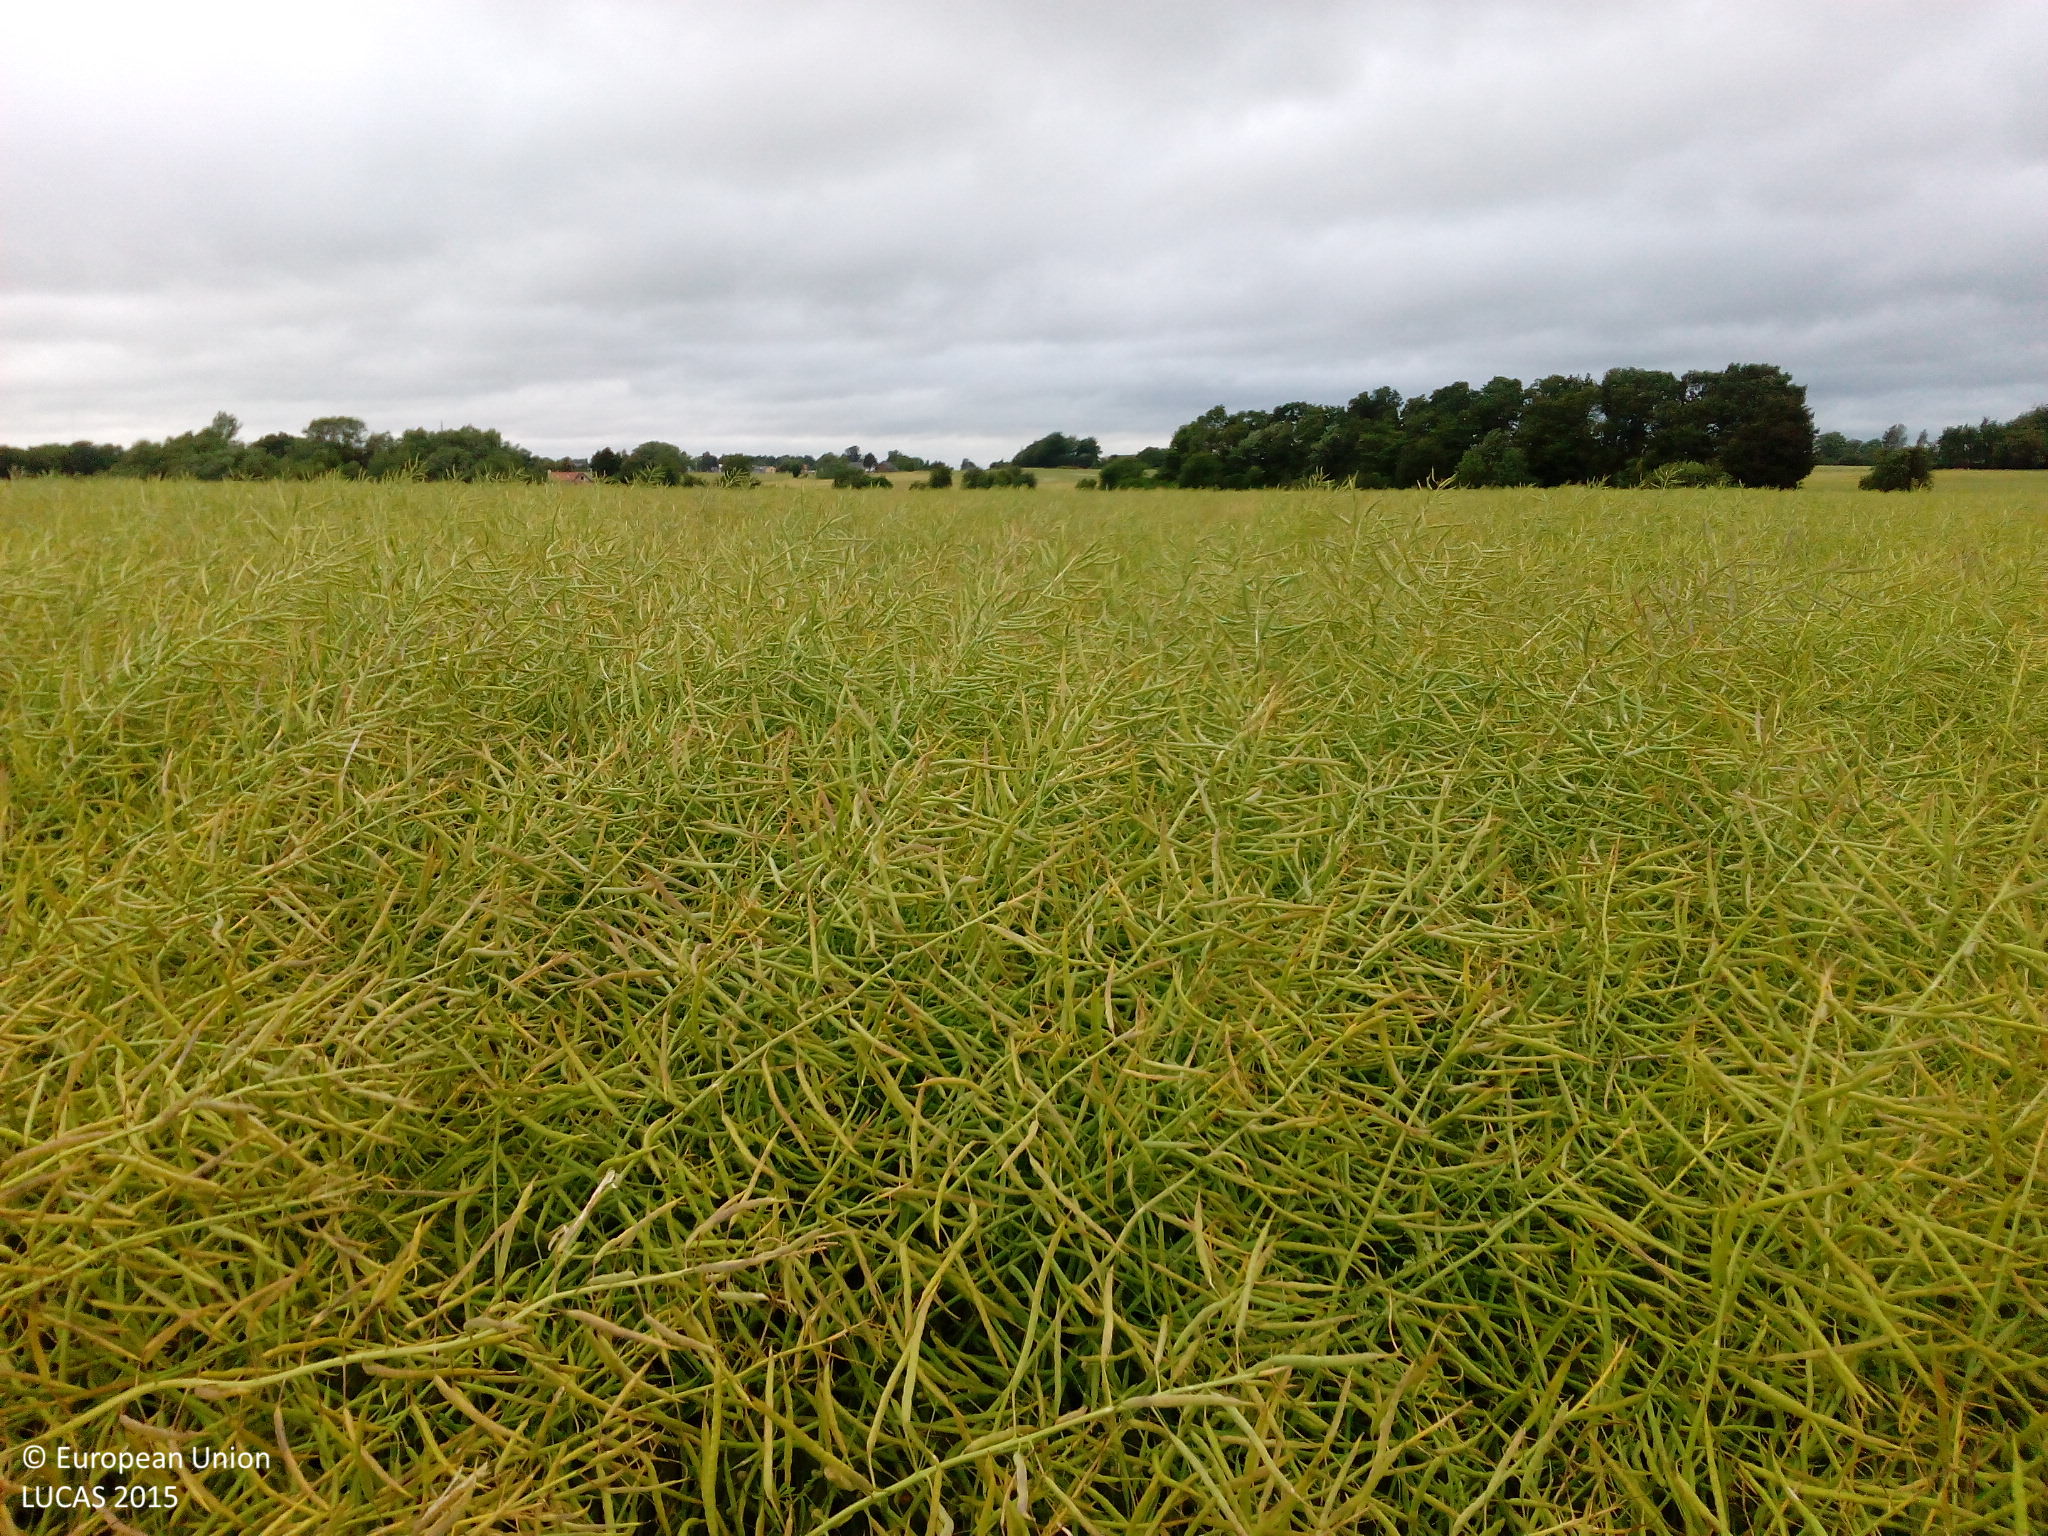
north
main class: Cropland
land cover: Rape and turnip rape
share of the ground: > 75 %
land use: Agriculture (excluding fallow land and kitchen gardens)
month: July
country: DK
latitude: 55.2809
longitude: 11.4315
